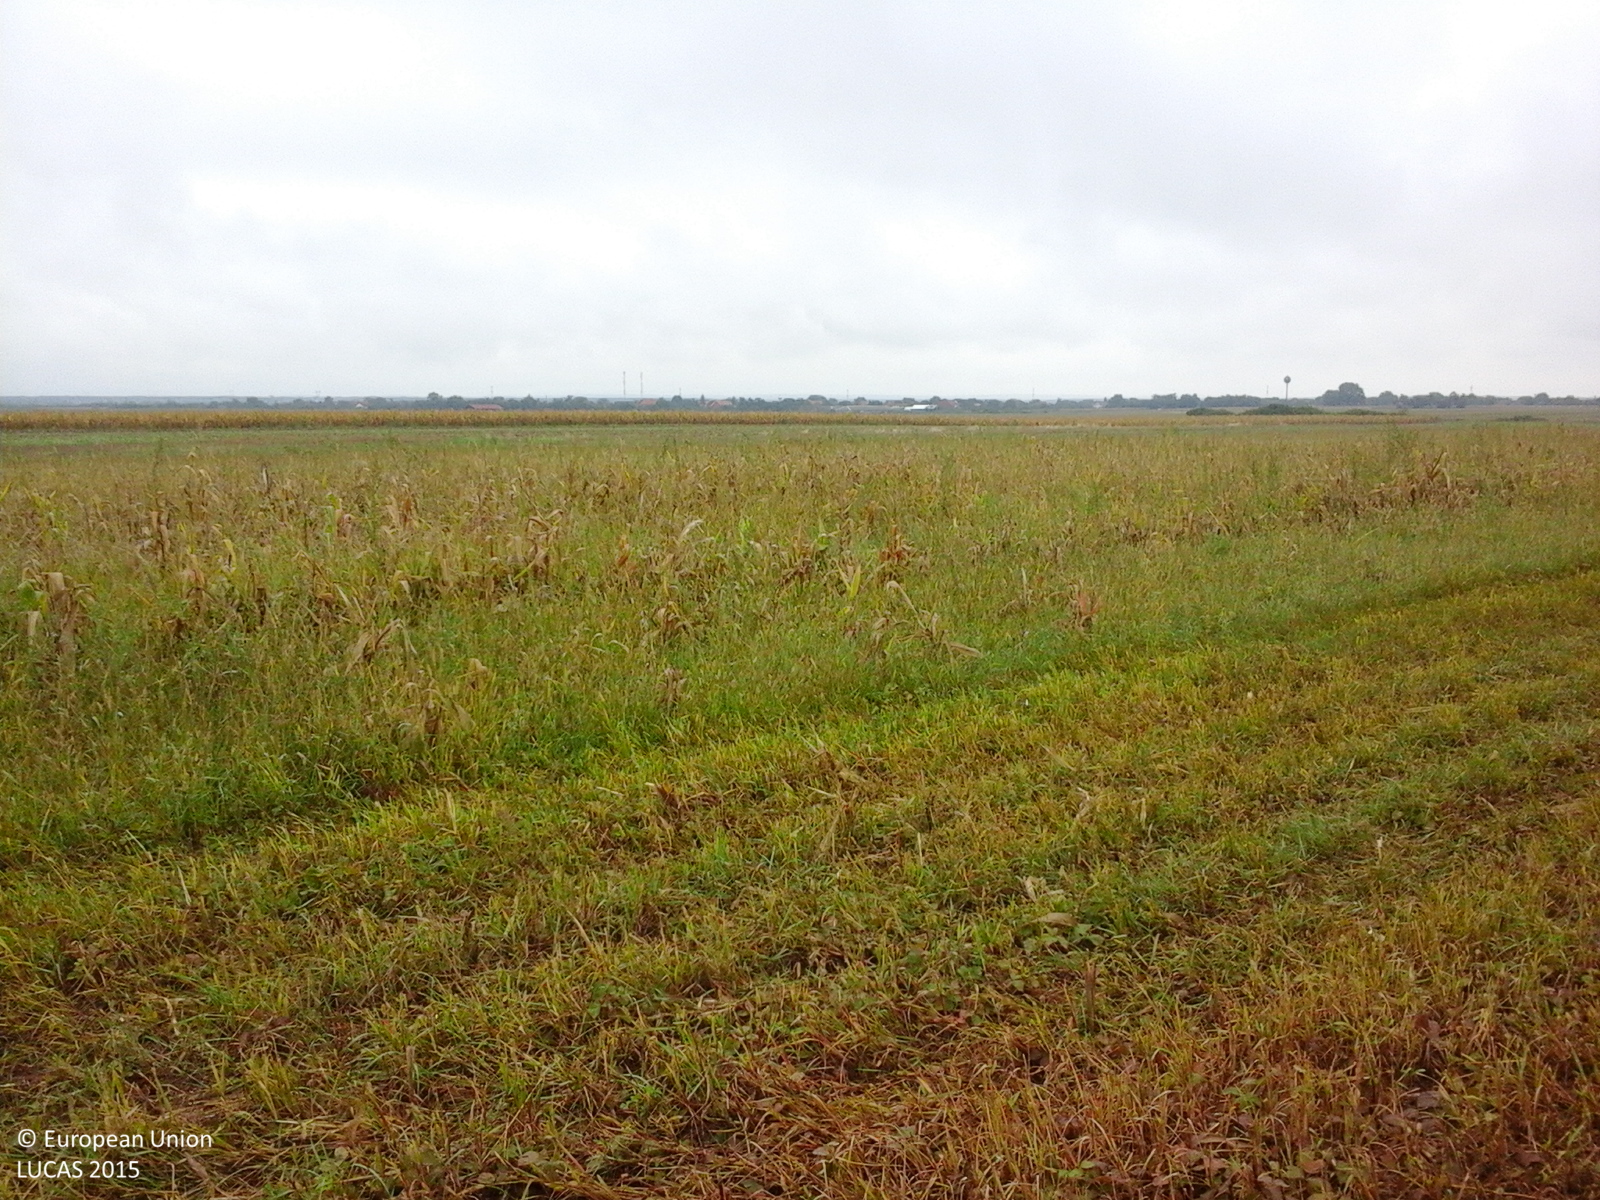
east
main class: Cropland
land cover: Maize
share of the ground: 50 - 75 %
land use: Agriculture (excluding fallow land and kitchen gardens)
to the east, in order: Maize; Common wheat; Maize; Common wheat
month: September
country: RO
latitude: 46.9355
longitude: 21.7735
